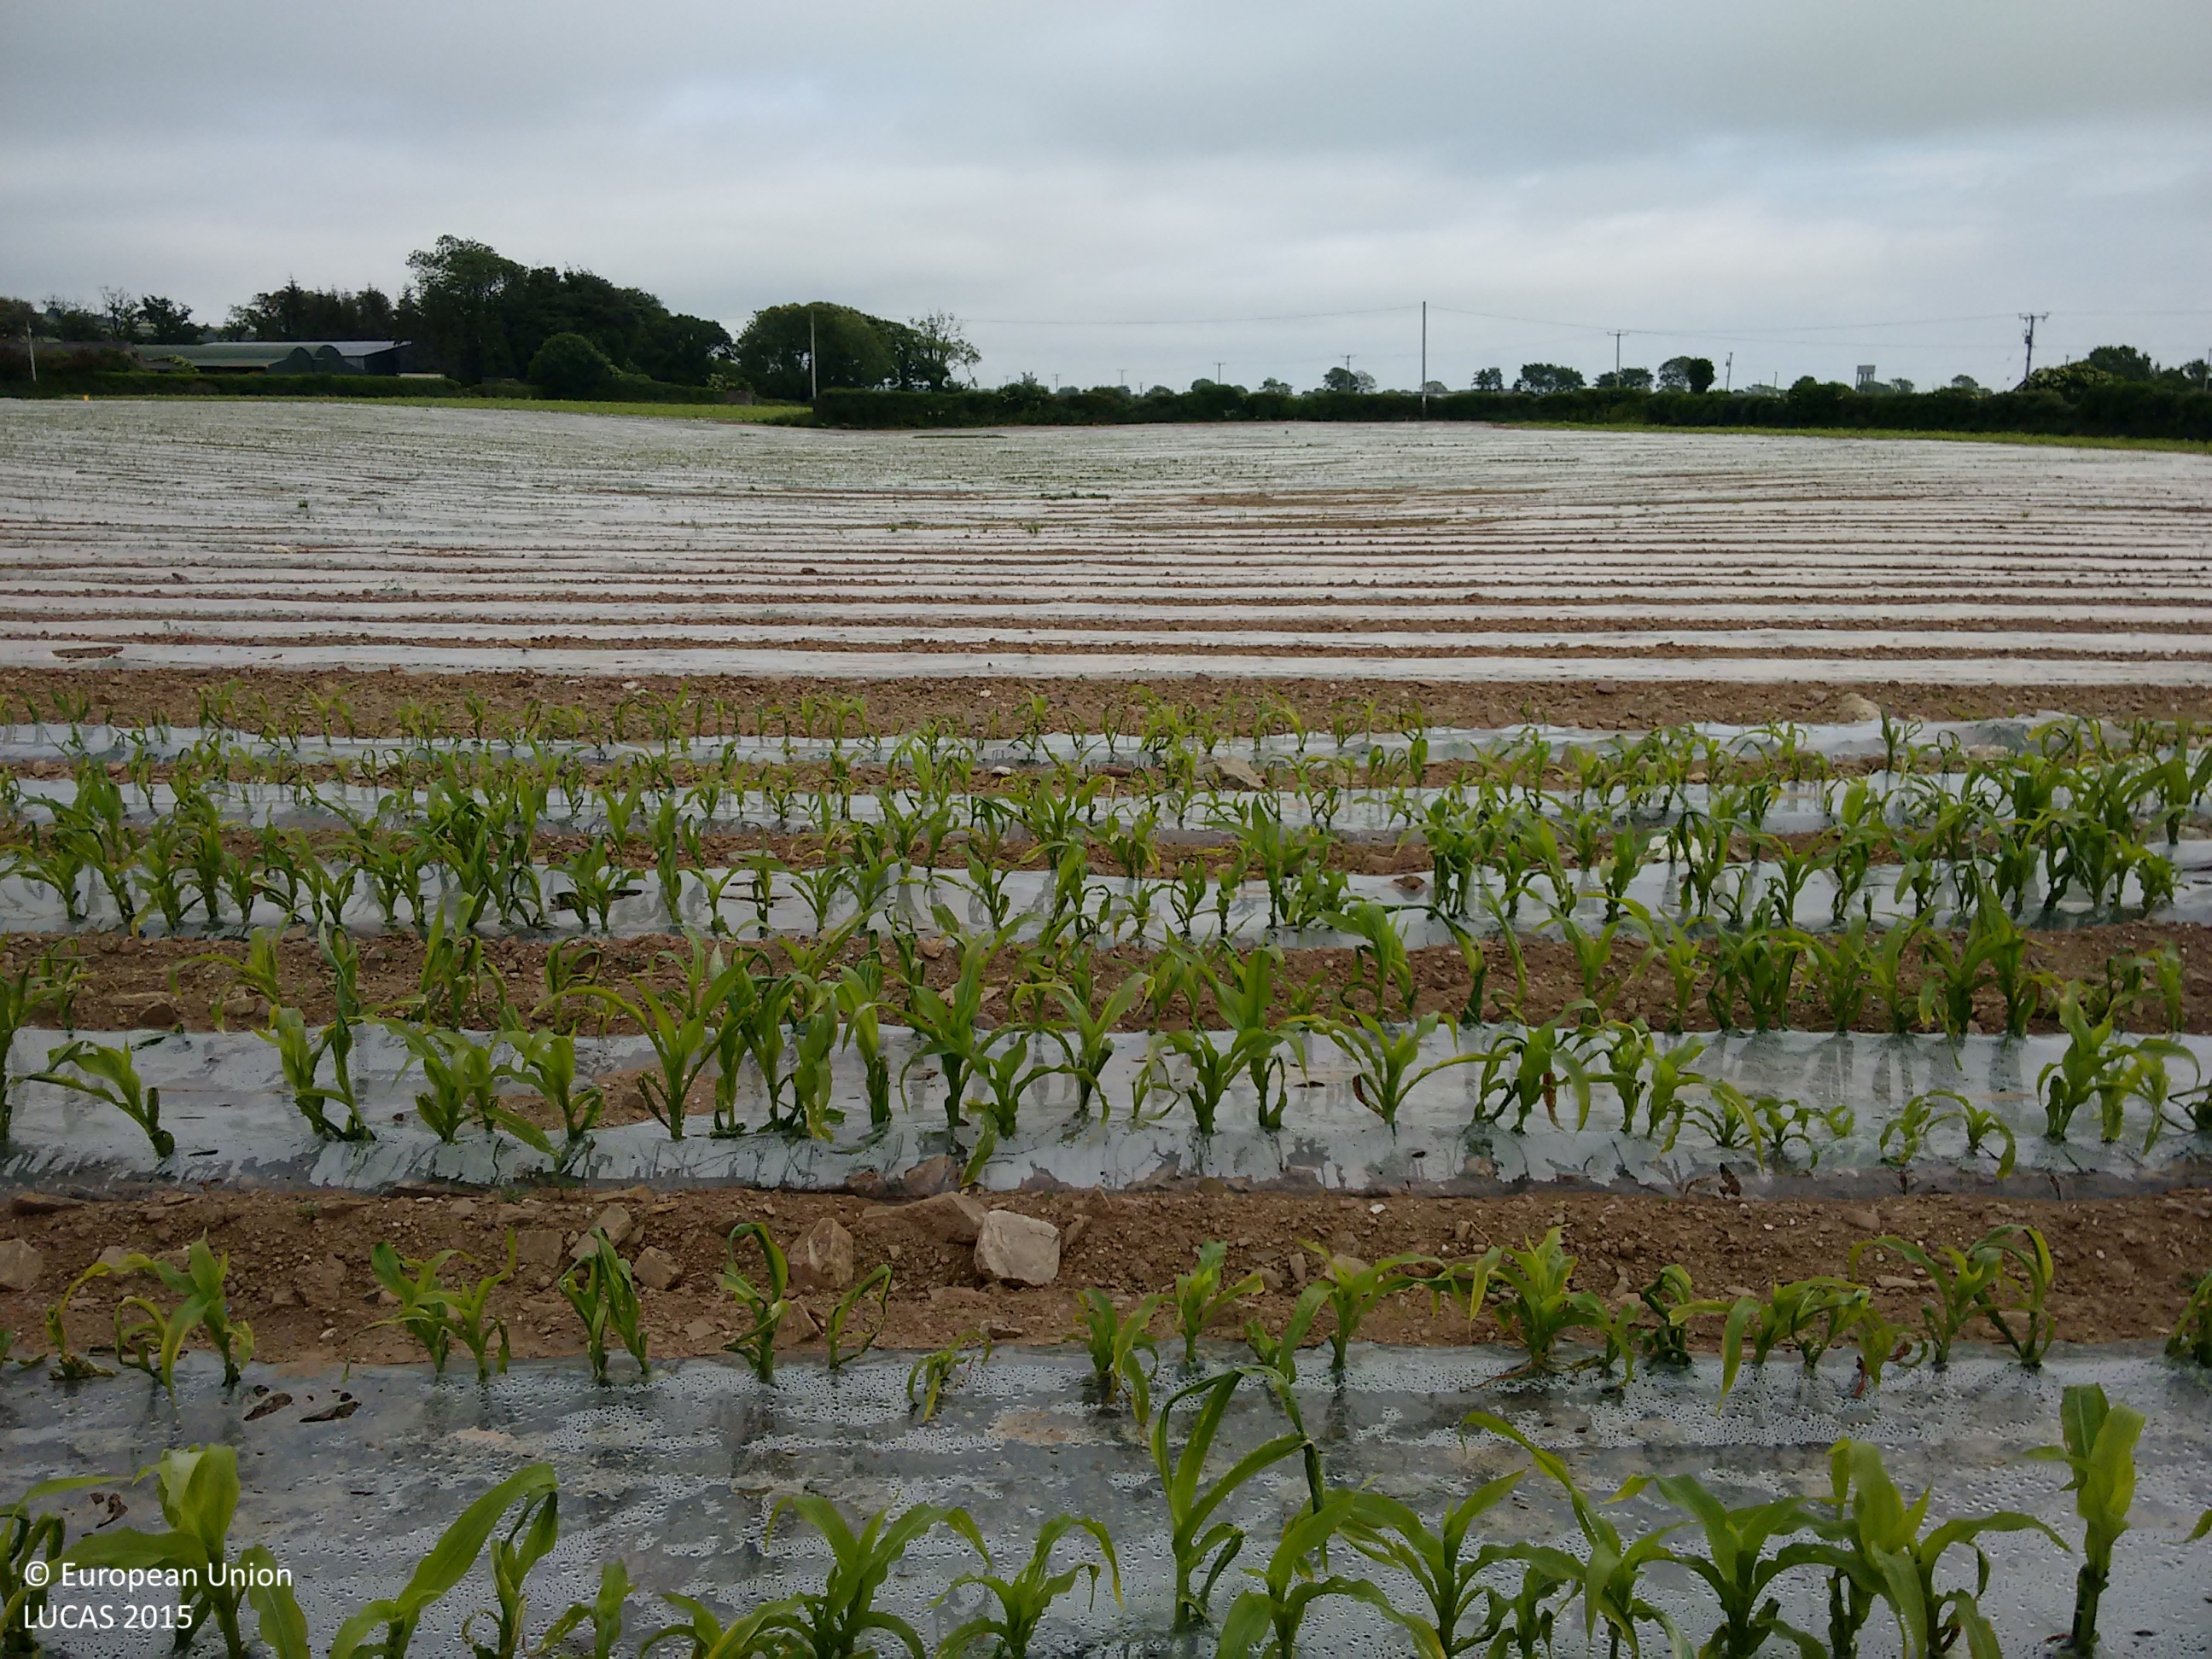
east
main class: Cropland
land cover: Rape and turnip rape
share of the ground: > 75 %
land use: Agriculture (excluding fallow land and kitchen gardens)
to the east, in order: Rape and turnip rape; Abandoned hedges; Maize
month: June
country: IE
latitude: 51.9355
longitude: -8.0536
